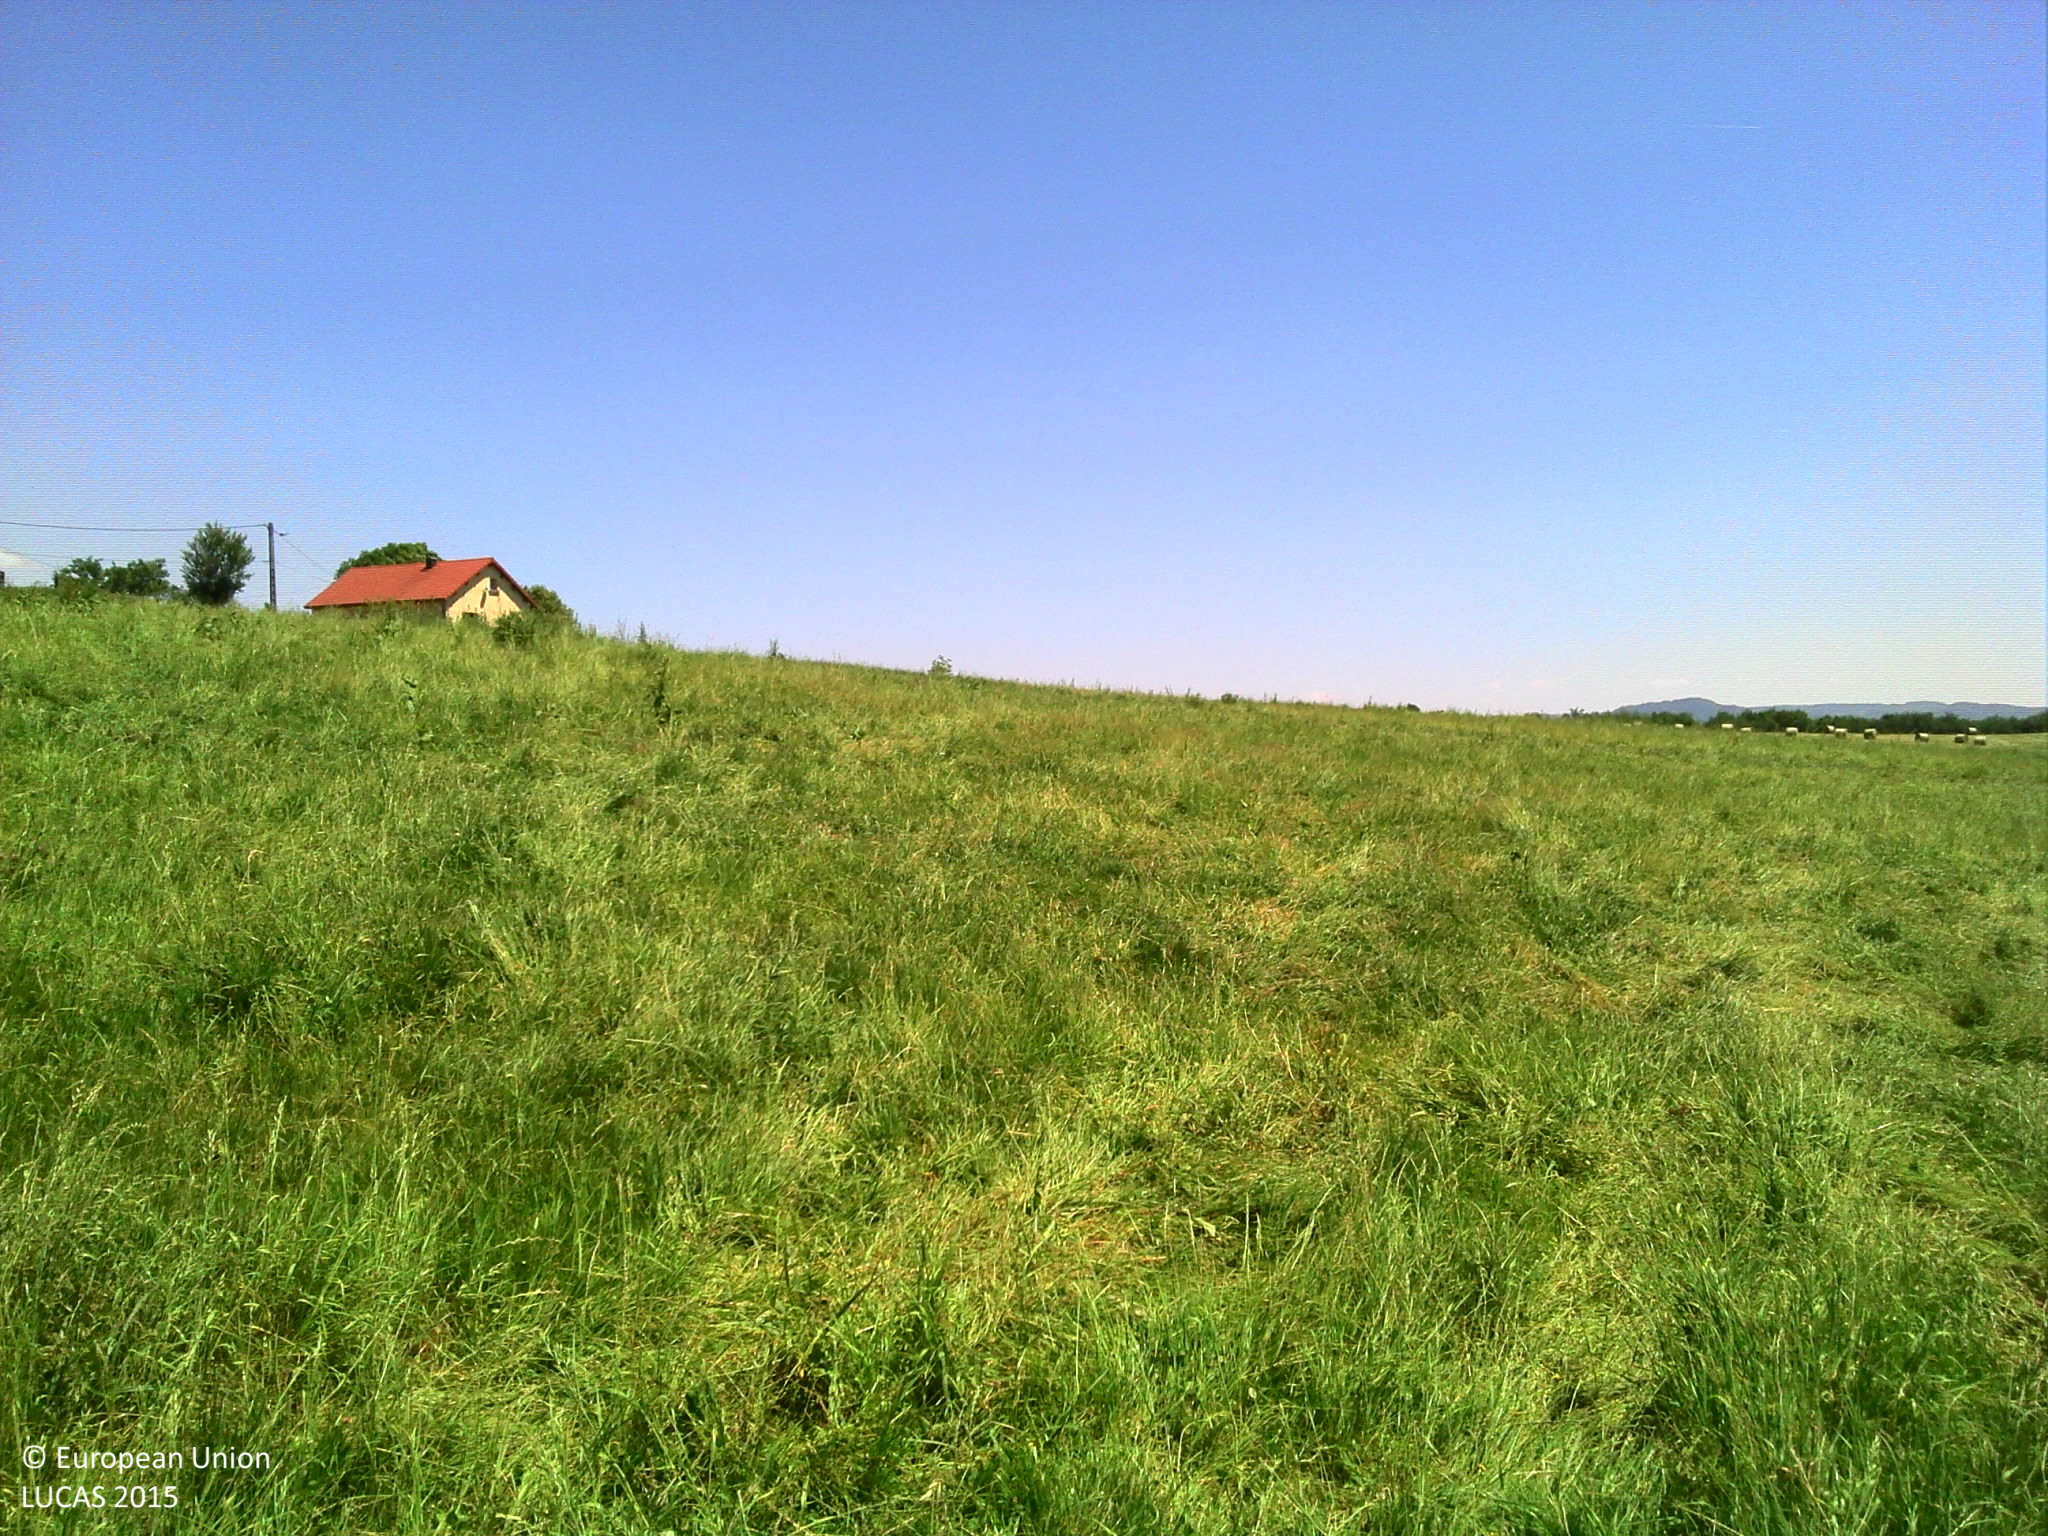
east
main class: Grassland
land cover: Grassland without tree/shrub cover
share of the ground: > 75 %
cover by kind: herbaceous plants 100 %
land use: Agriculture (excluding fallow land and kitchen gardens)
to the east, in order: Grassland without tree/shrub cover; Fences; Ditches and canals; Grass margins; Paved roads, cycling and walking lanes; Grass margins; Ditches and canals; Spontaneously vegetated surfaces; Fences; Other bare soil; Grassland without tree/shrub cover
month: June
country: FR
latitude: 45.3590
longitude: 2.4286
